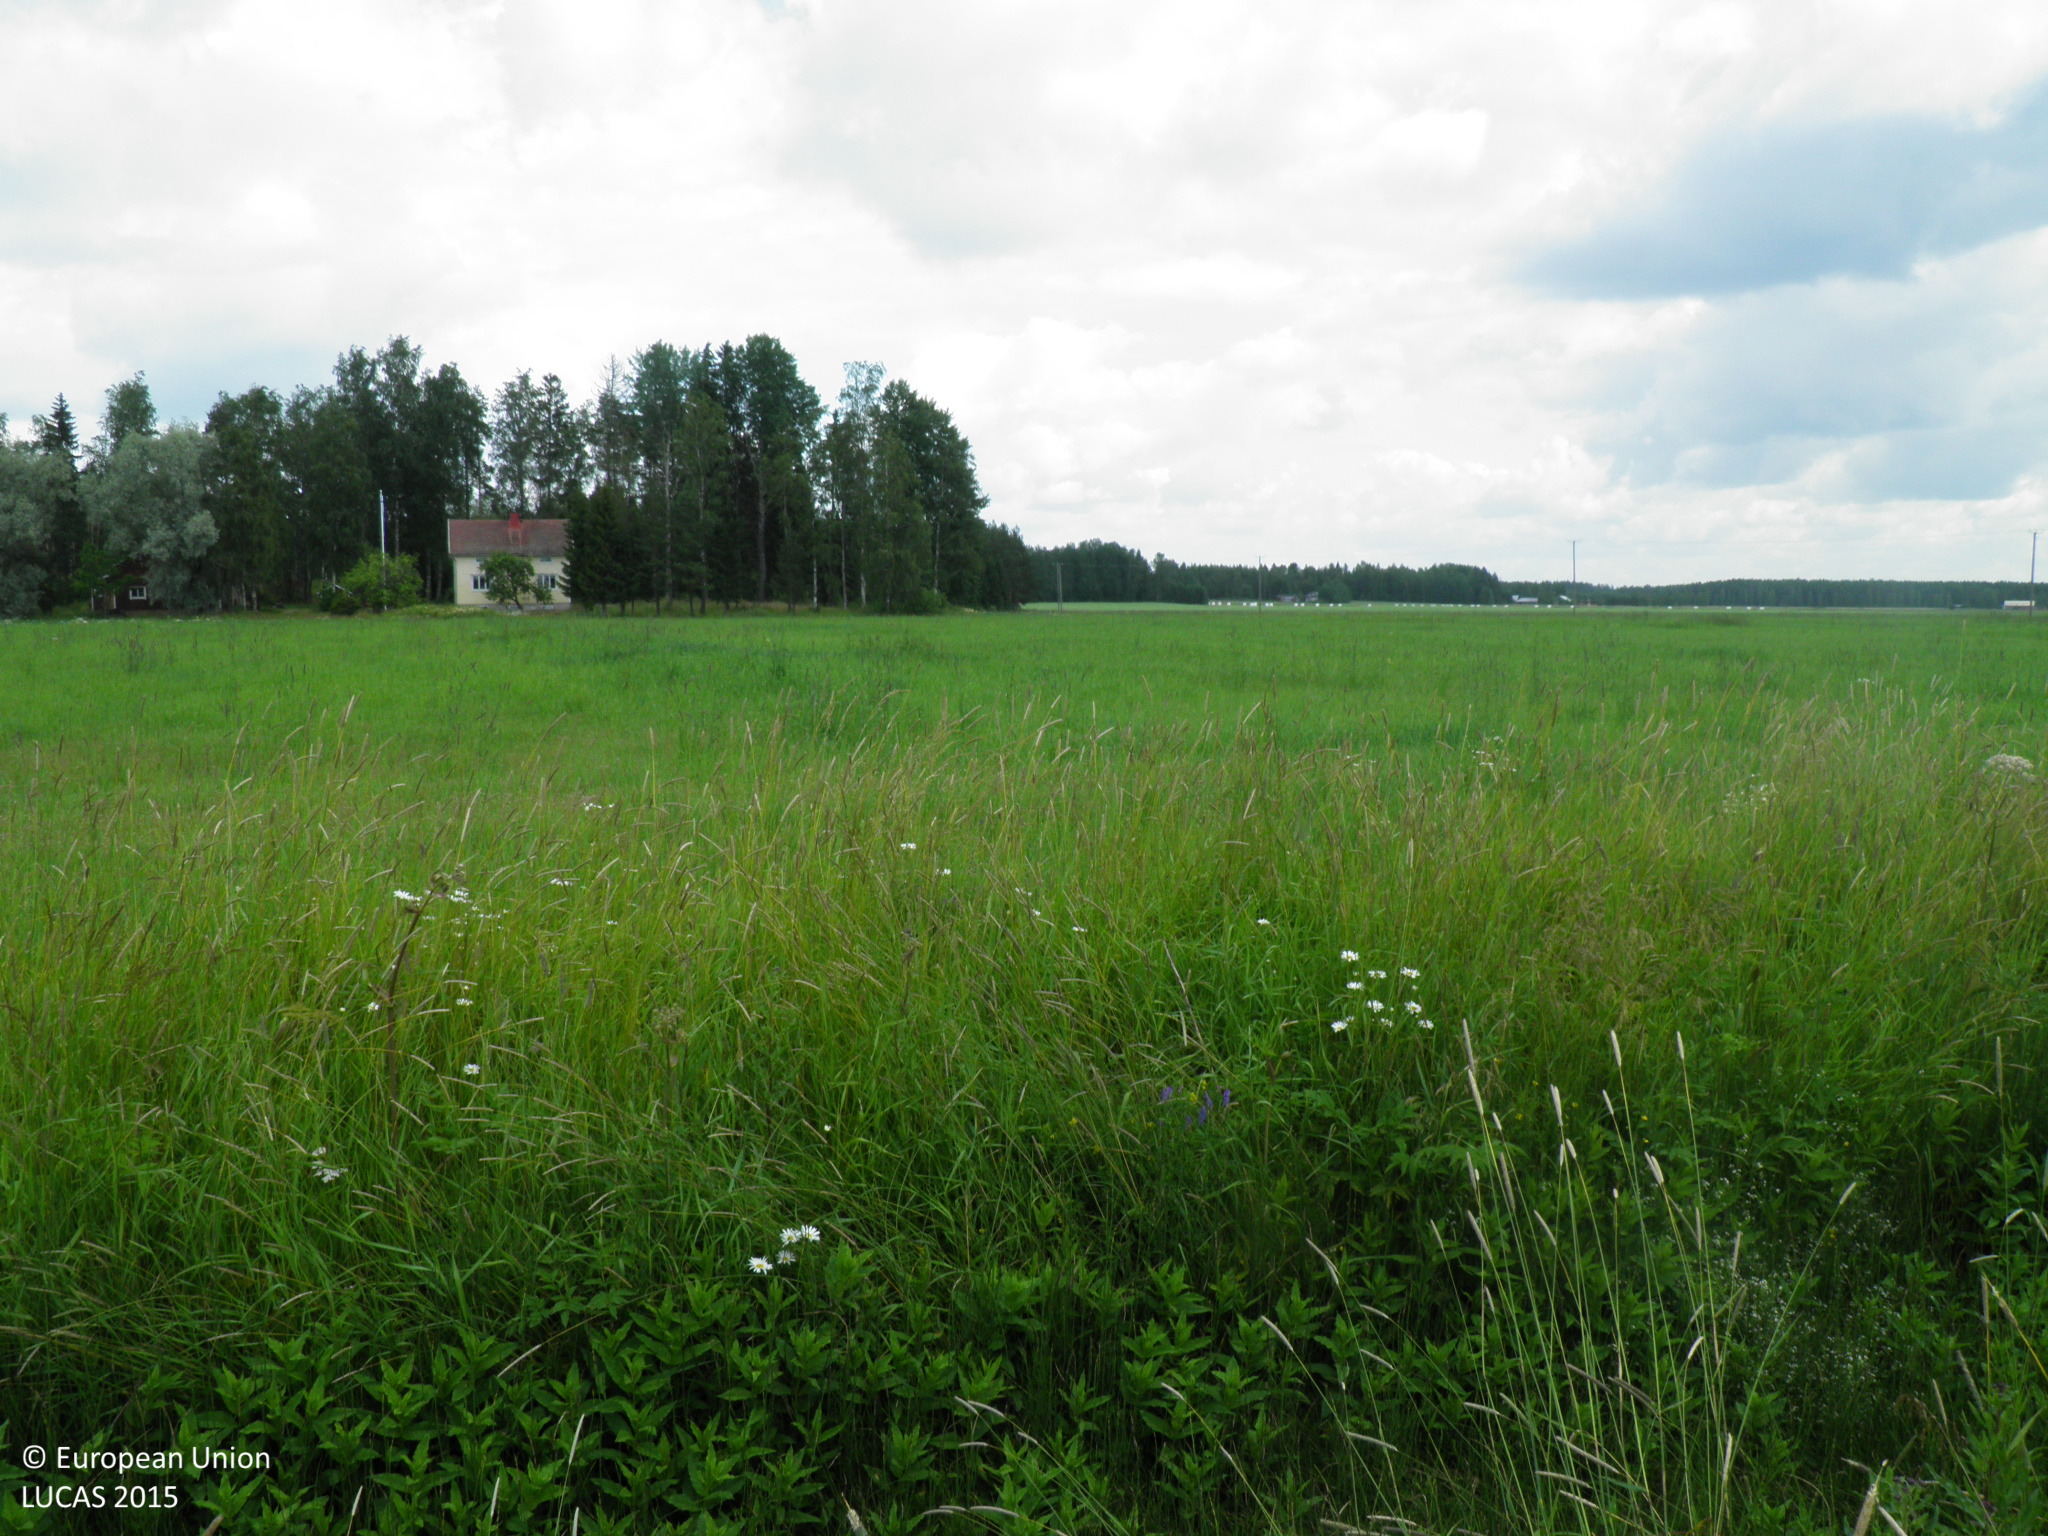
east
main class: Cropland
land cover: Barley
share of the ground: > 75 %
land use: Agriculture (excluding fallow land and kitchen gardens)
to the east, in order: Barley; Grass margins; Ditches and canals; Grass margins; Oats; Electric lines; Oats
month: July
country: FI
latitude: 60.6553
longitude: 22.3787
